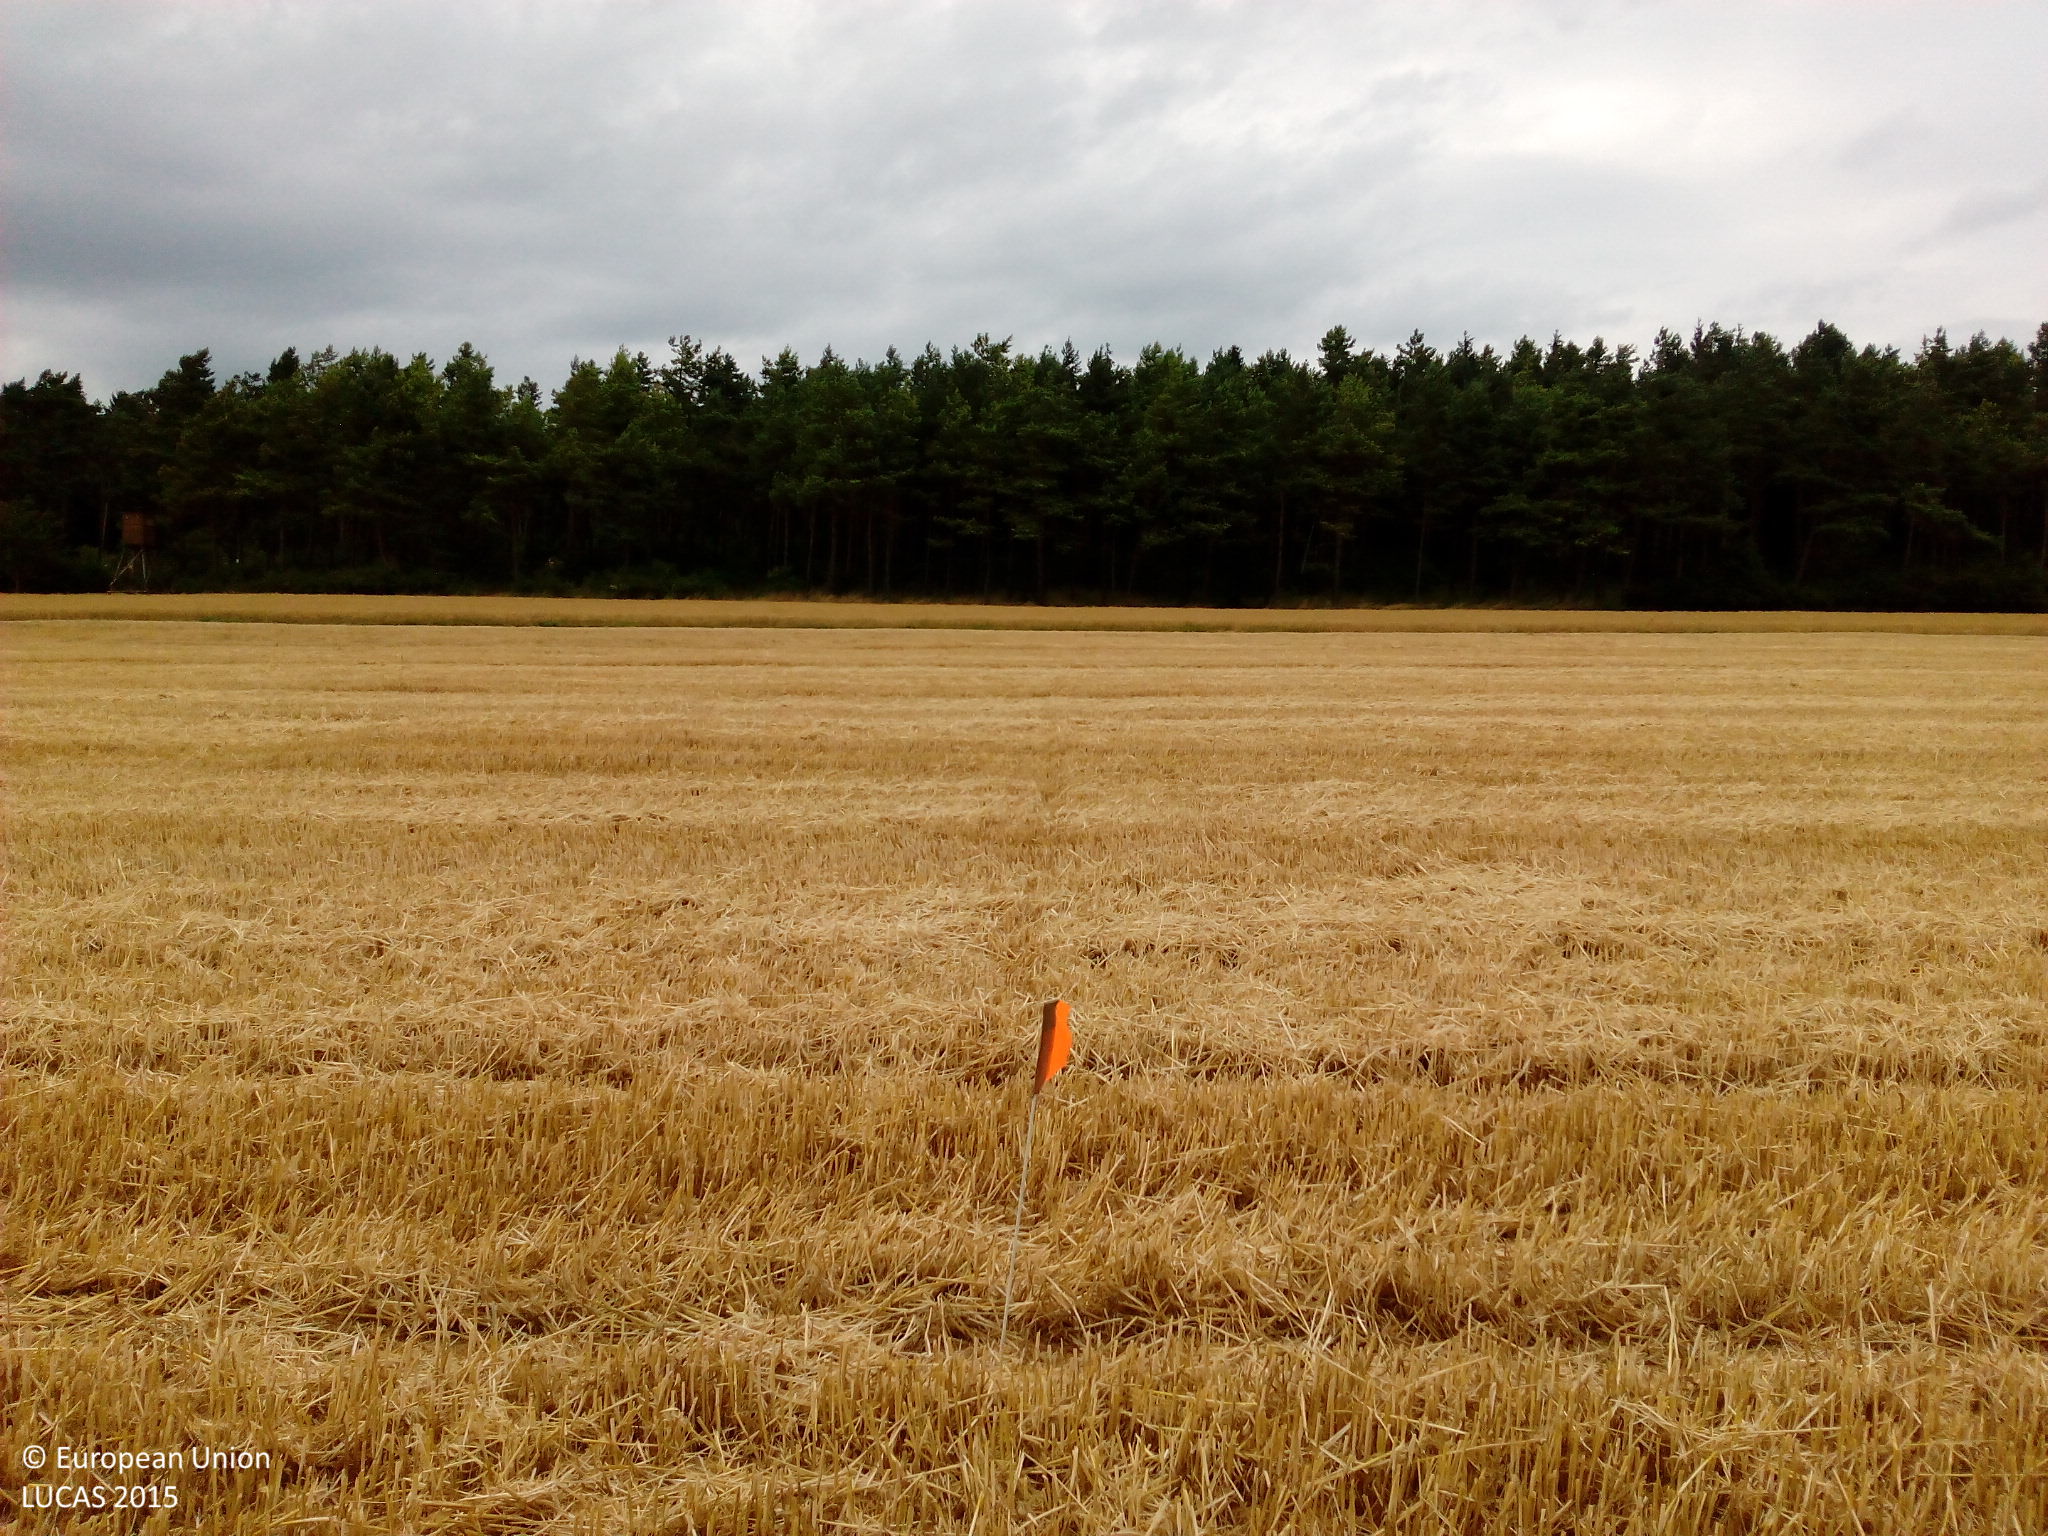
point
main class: Cropland
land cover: Common wheat
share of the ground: 10 - 25 %
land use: Agriculture (excluding fallow land and kitchen gardens)
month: July
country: DE
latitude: 48.7809
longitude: 10.3128
